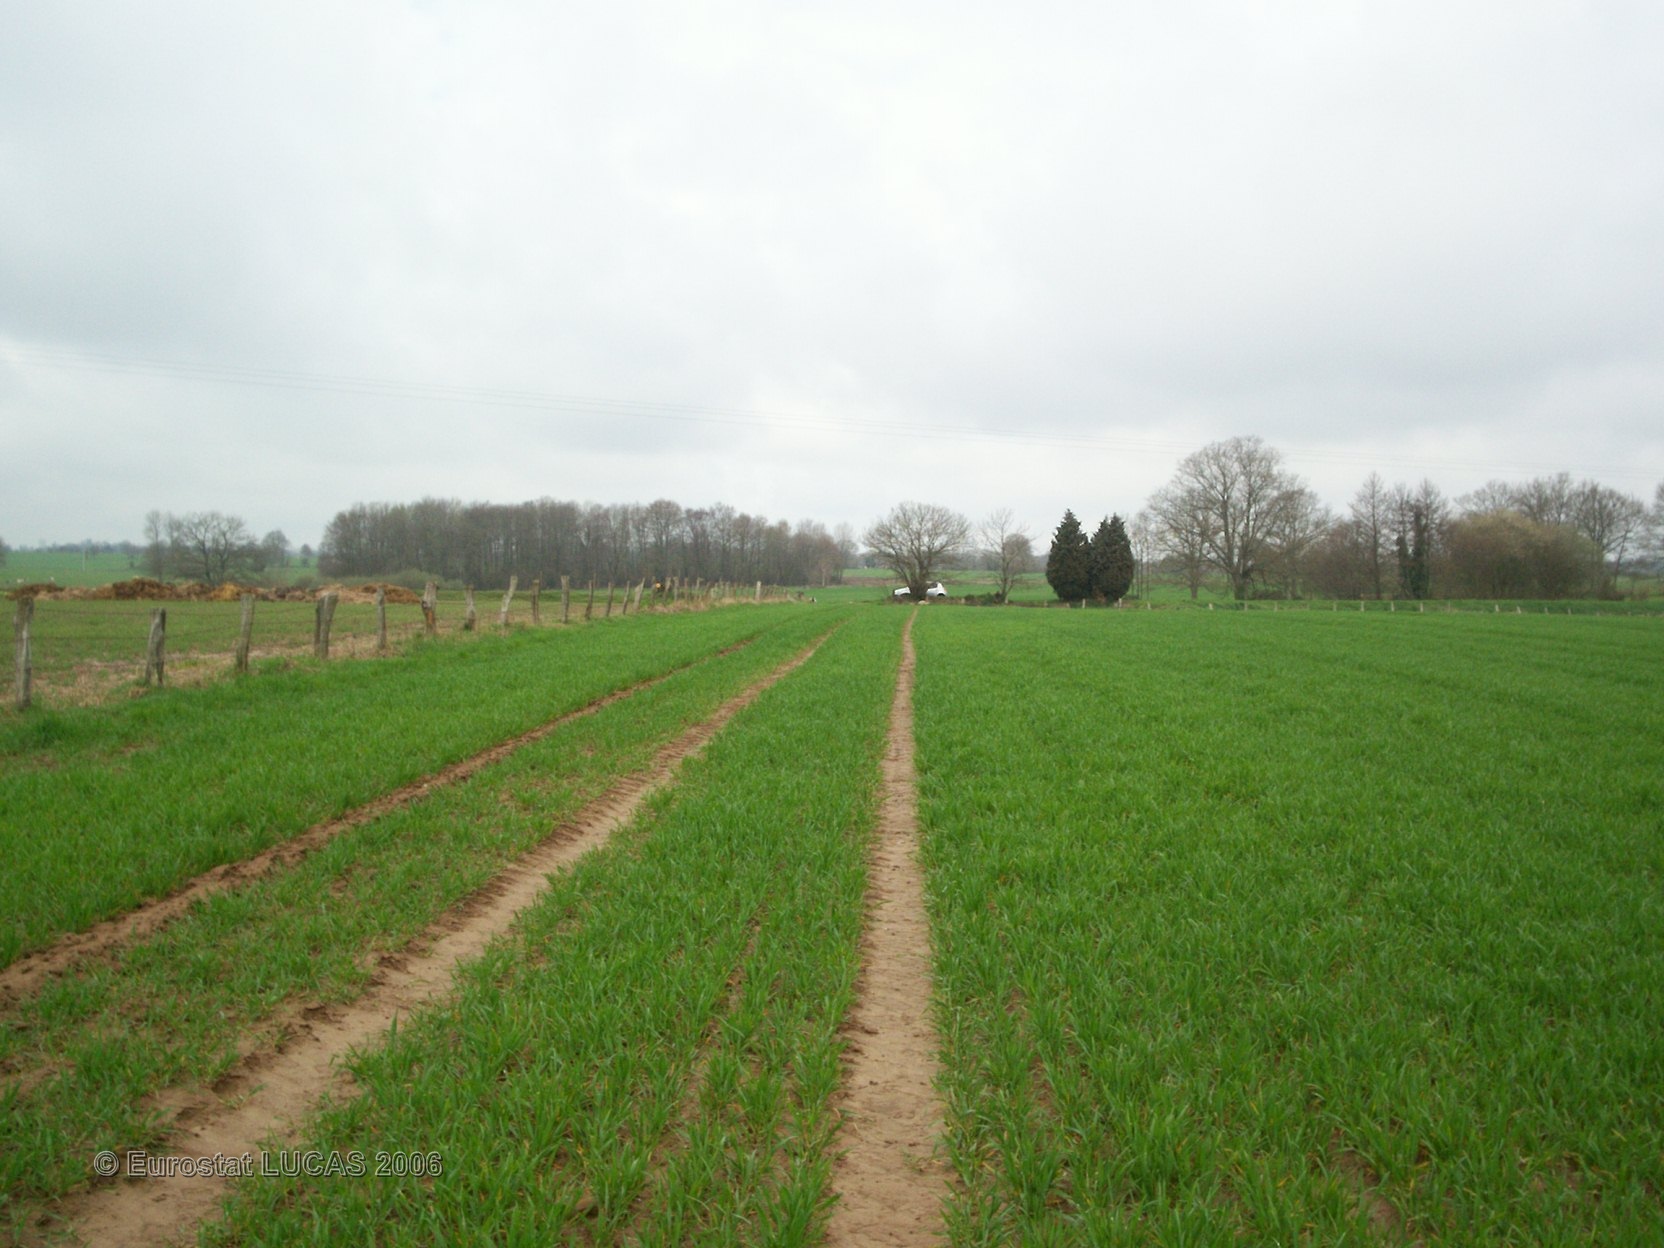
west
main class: Cropland
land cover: Common wheat
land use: Agriculture (excluding fallow land and kitchen gardens)
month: April
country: FR
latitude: 48.4450
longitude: -0.7035
